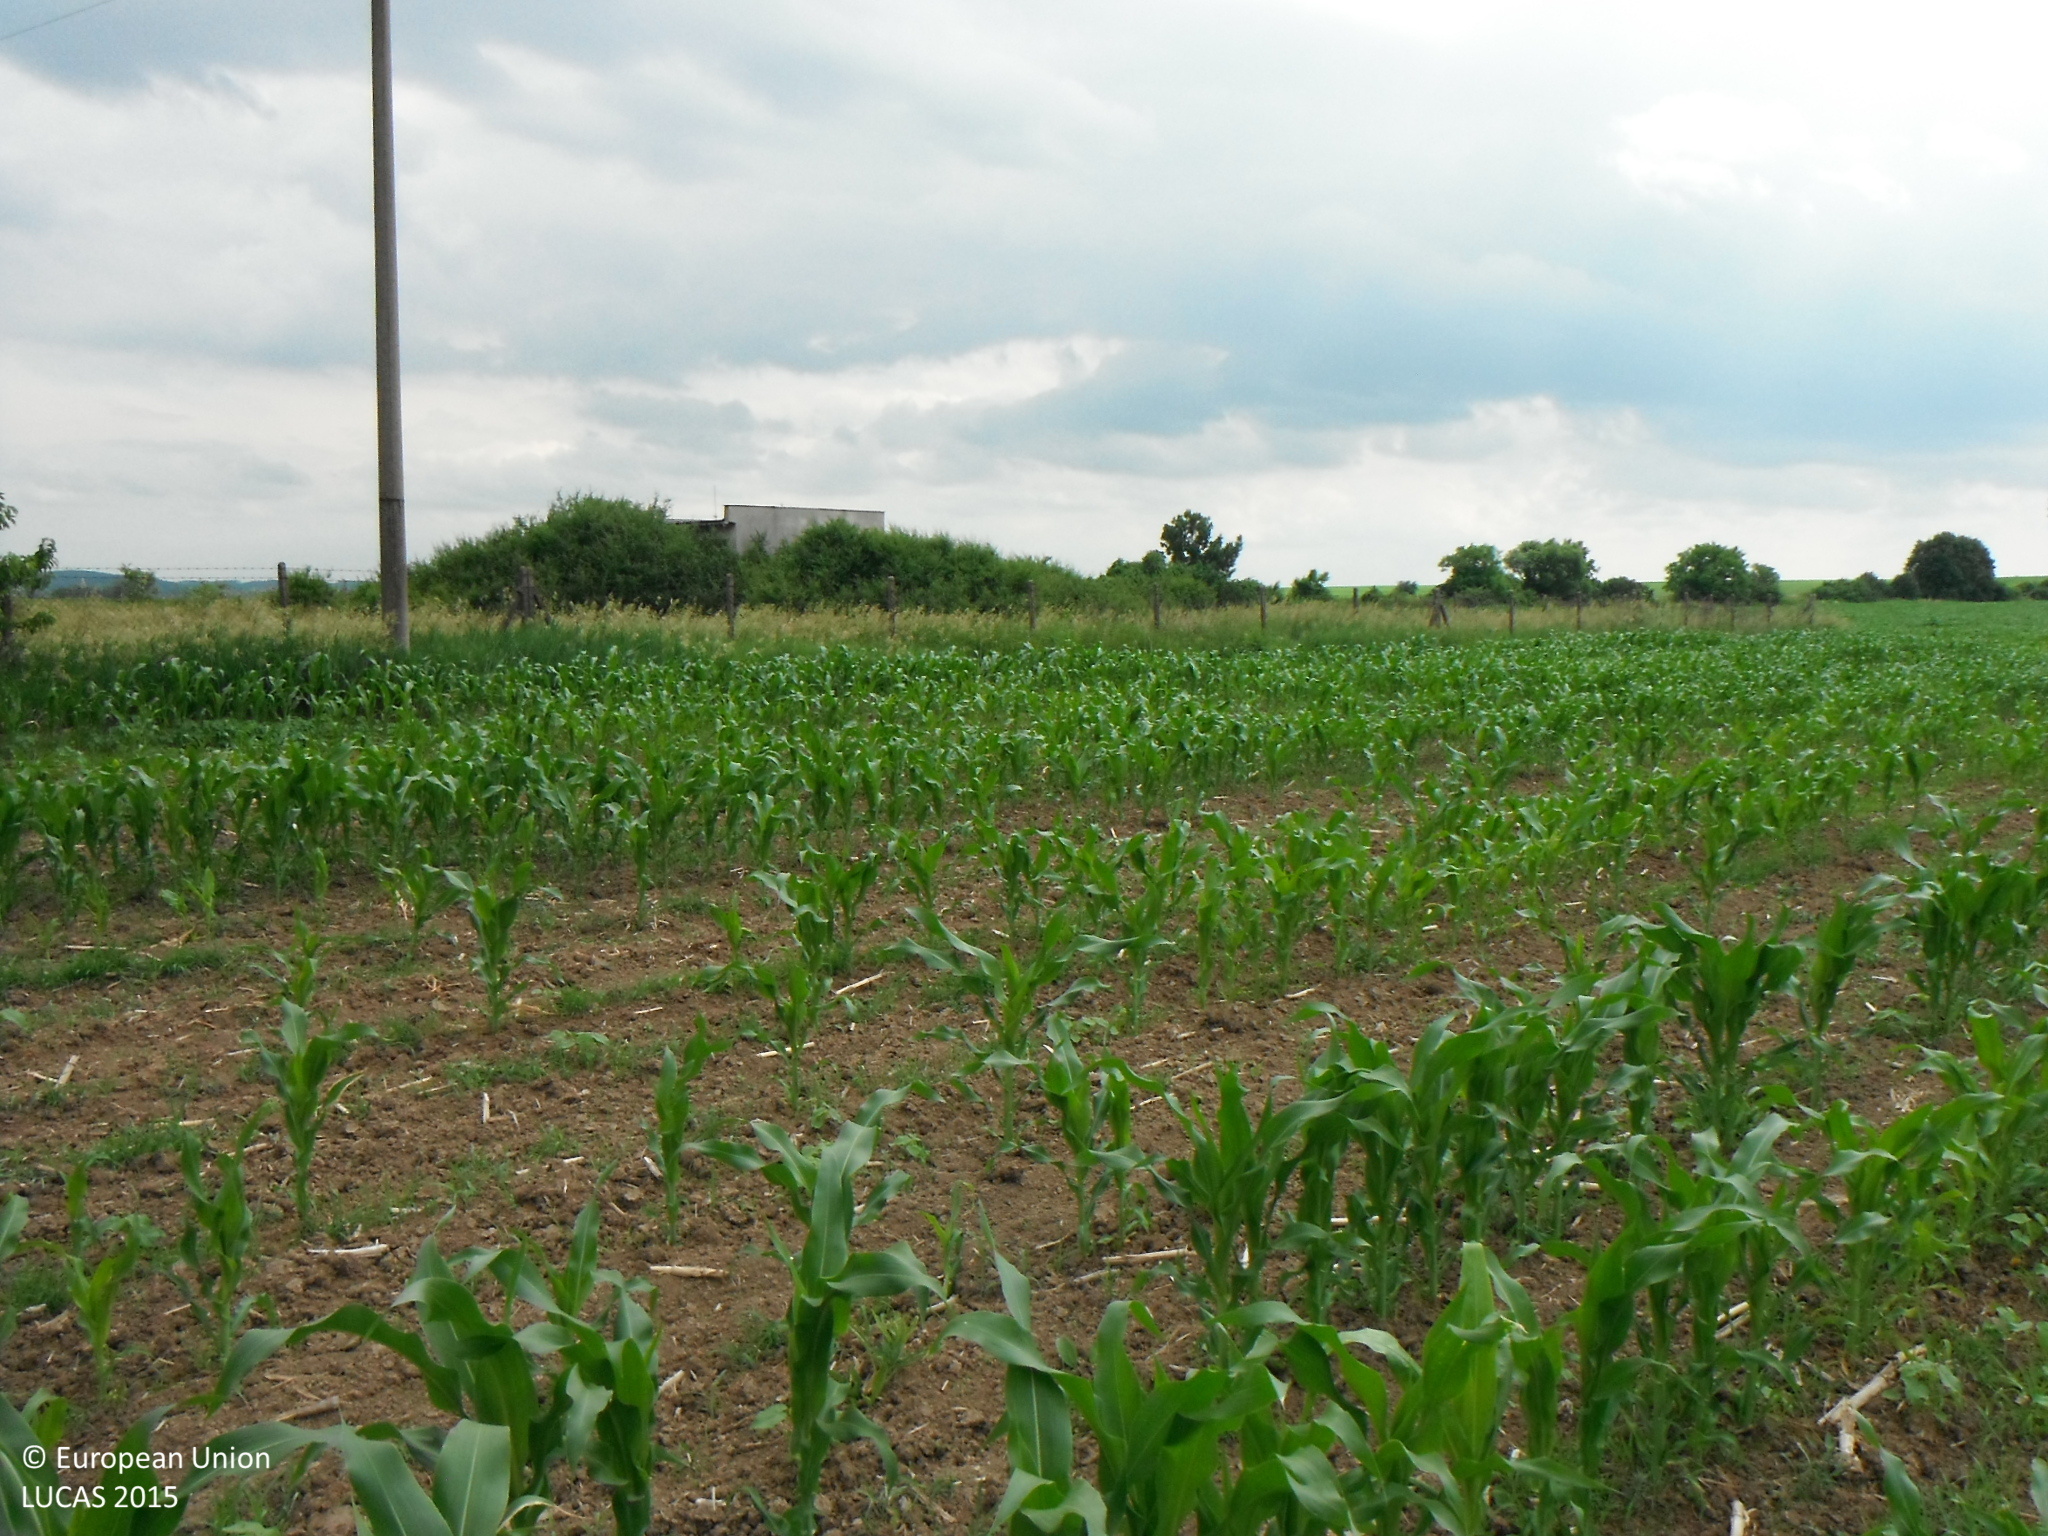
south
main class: Cropland
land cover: Maize
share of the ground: 50 - 75 %
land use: Agriculture (excluding fallow land and kitchen gardens)
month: June
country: SK
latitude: 48.1703
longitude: 19.3411
